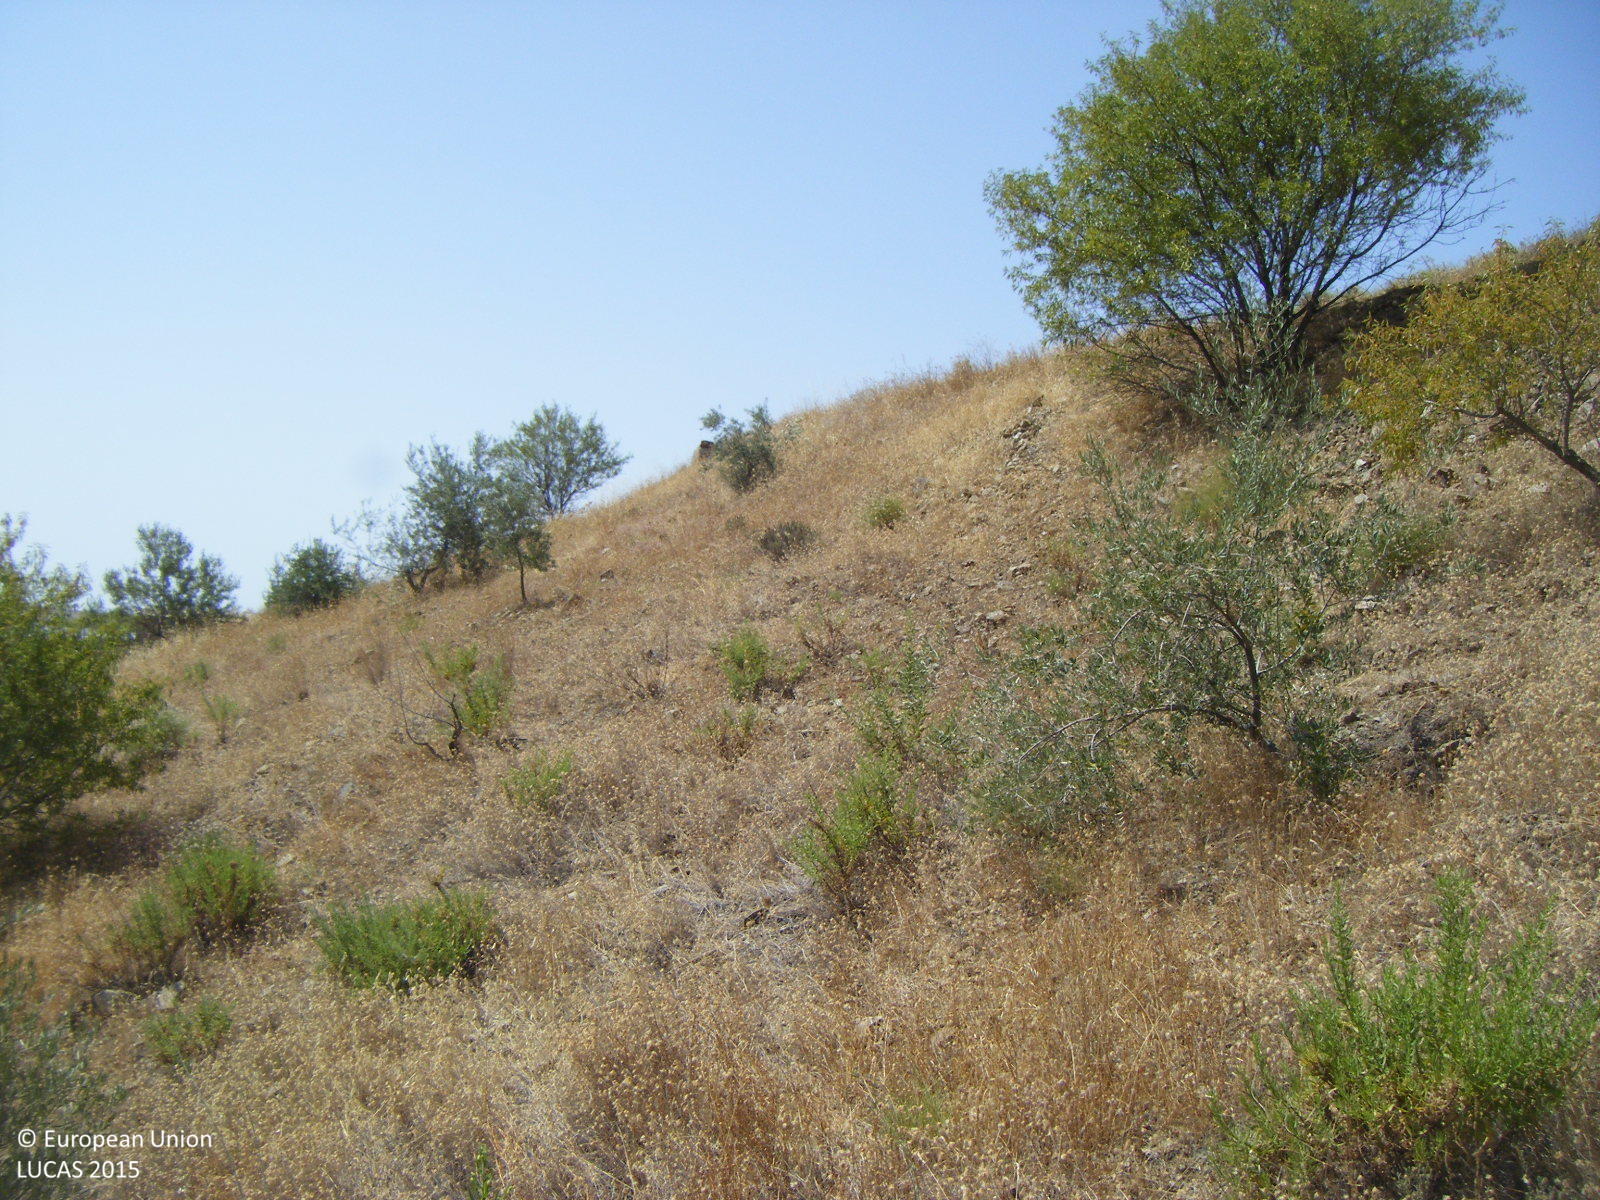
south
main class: Shrubland
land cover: Shrubland without tree cover
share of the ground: 50 - 75 %
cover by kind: shrubs 60 %, herbaceous plants 40 %
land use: Semi-natural and natural areas not in use
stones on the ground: 10 - 25 %
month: July
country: ES
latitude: 36.8619
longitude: -4.0656
